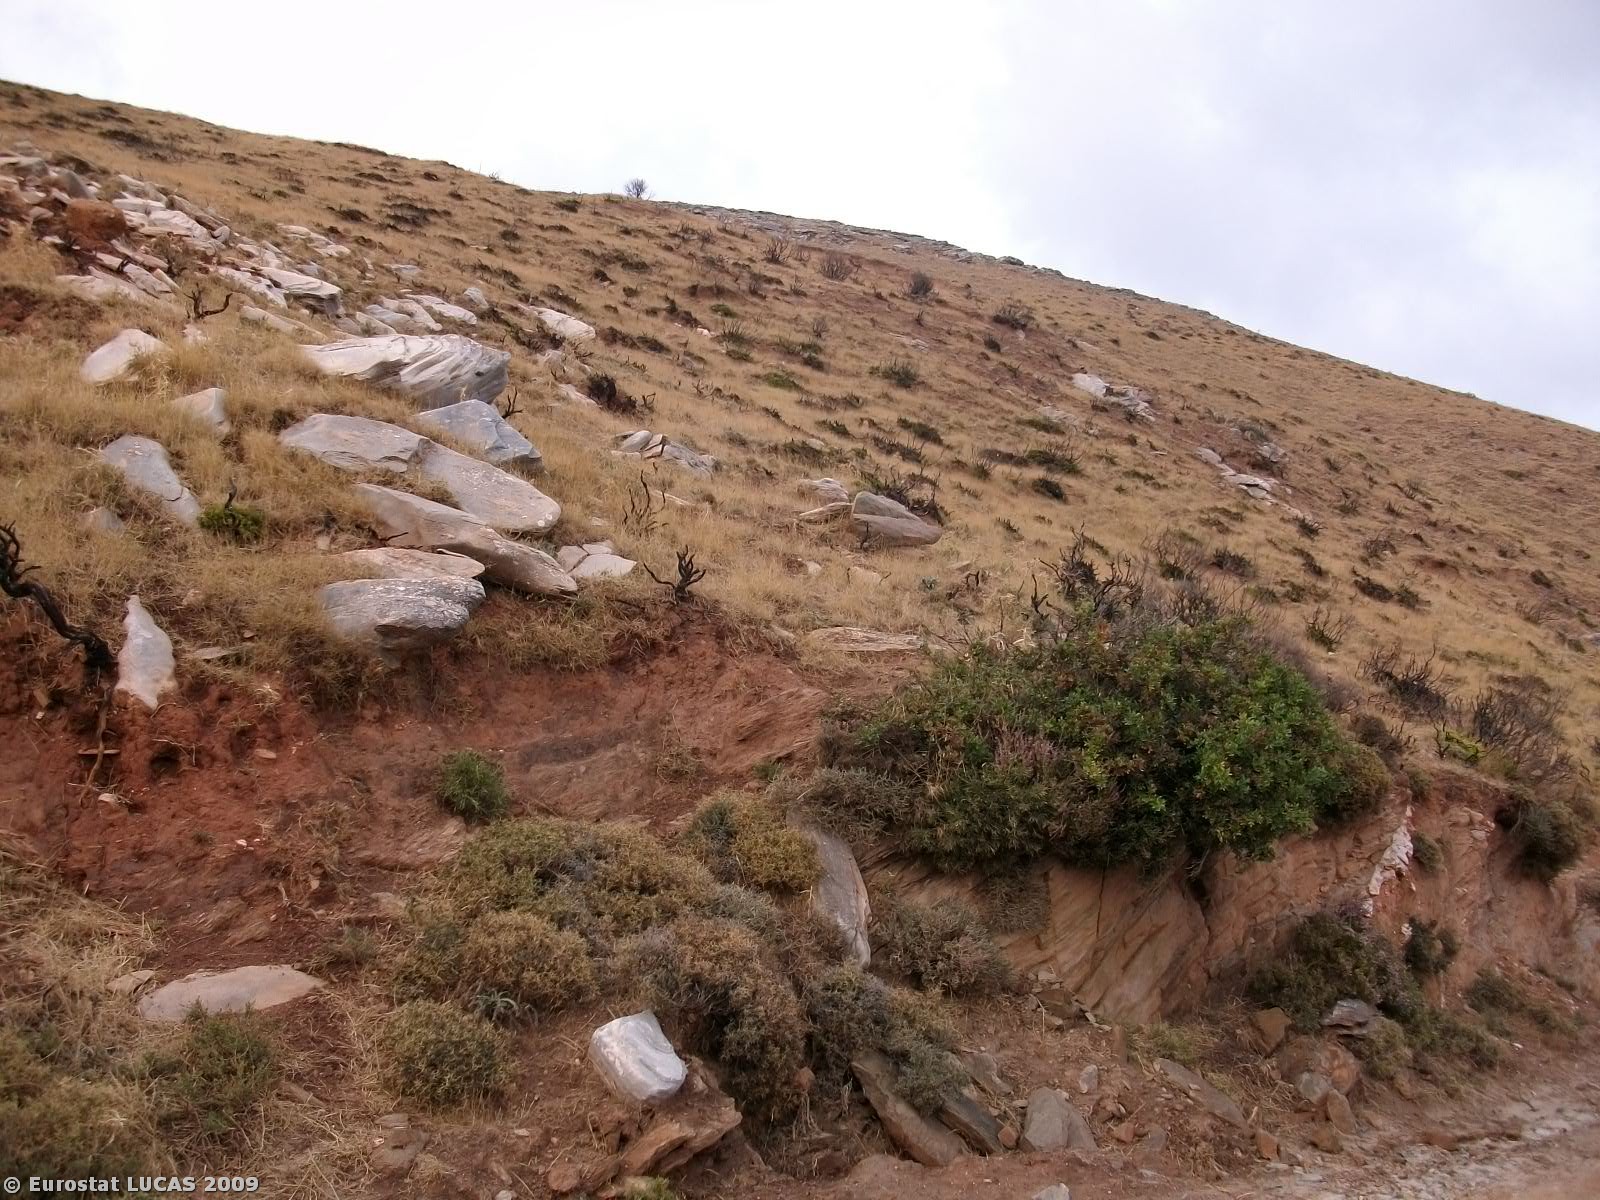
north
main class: Shrubland
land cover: Shrubland without tree cover
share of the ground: > 75 %
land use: Unused
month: September
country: GR
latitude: 38.1188
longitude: 24.2581
